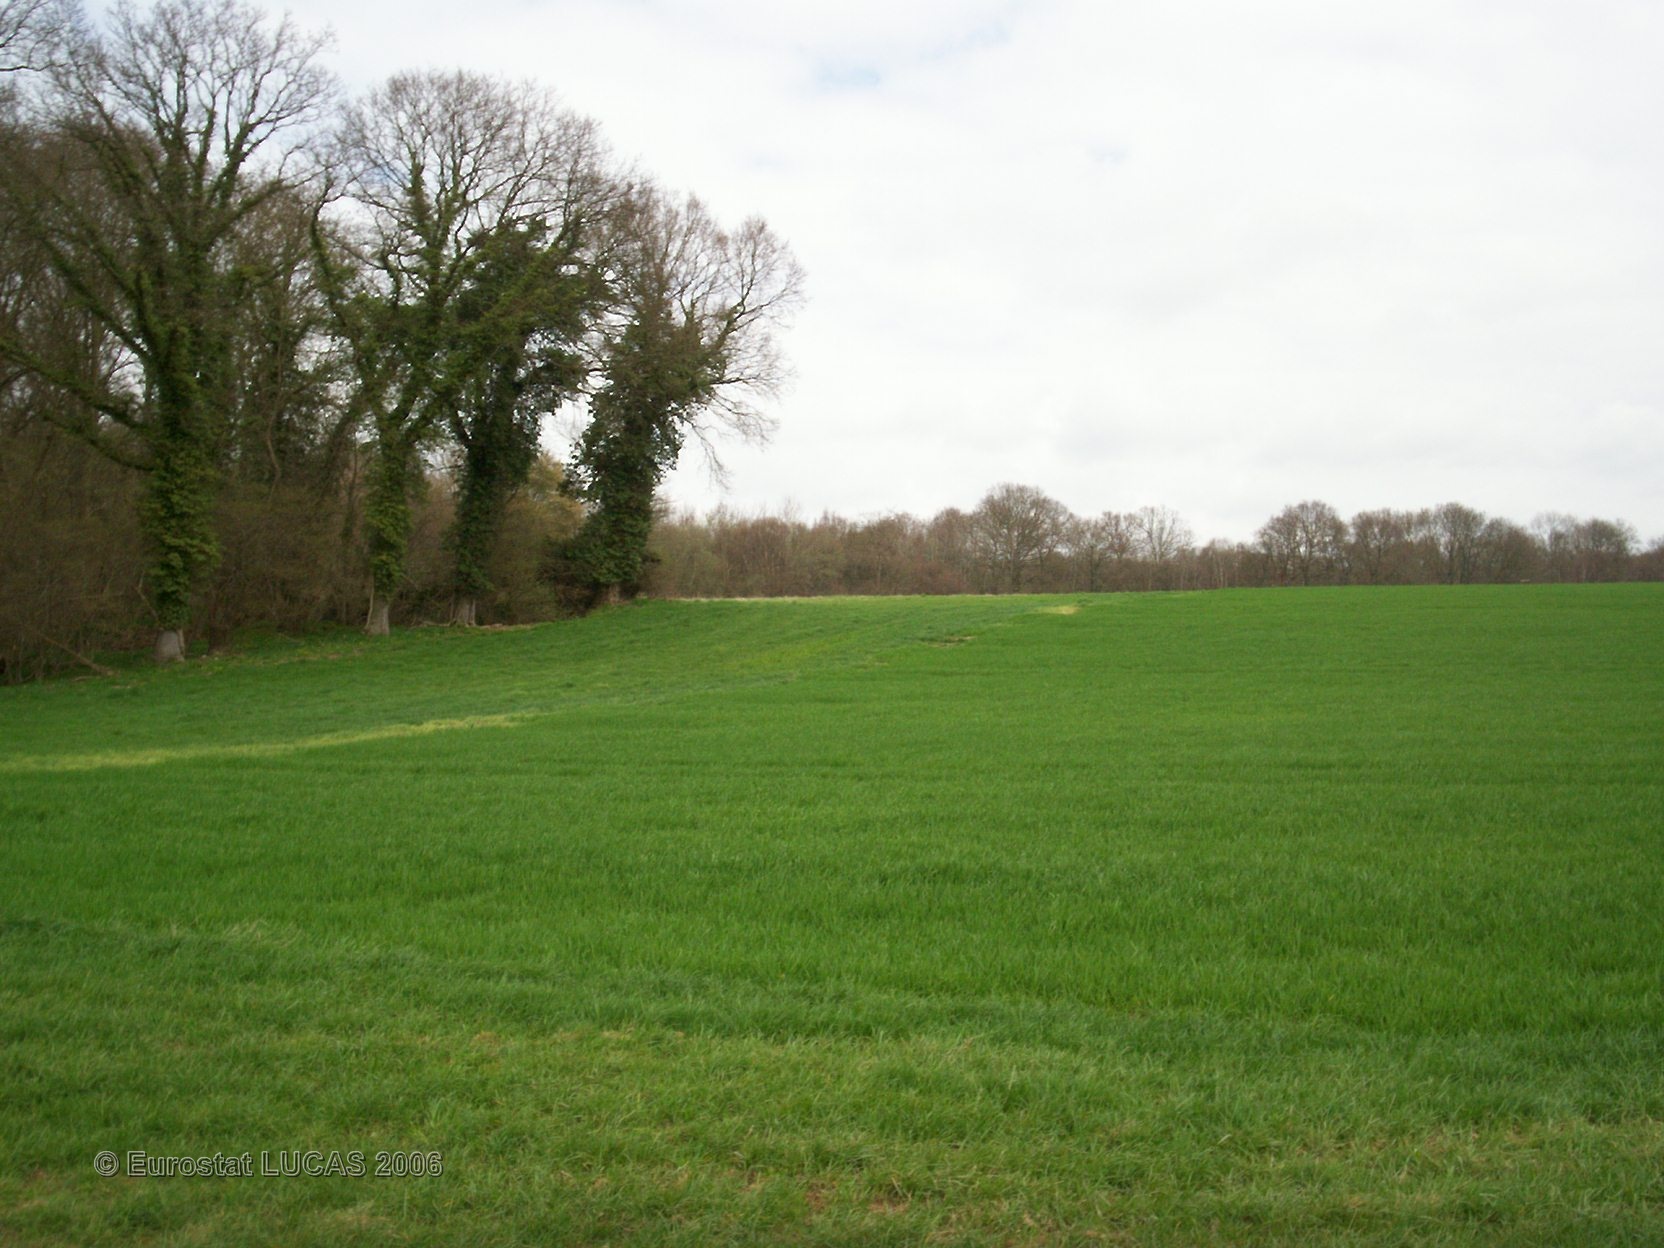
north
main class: Grassland
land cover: Grassland without tree/shrub cover
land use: Agriculture (excluding fallow land and kitchen gardens)
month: April
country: FR
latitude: 49.7306
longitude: 0.9173
